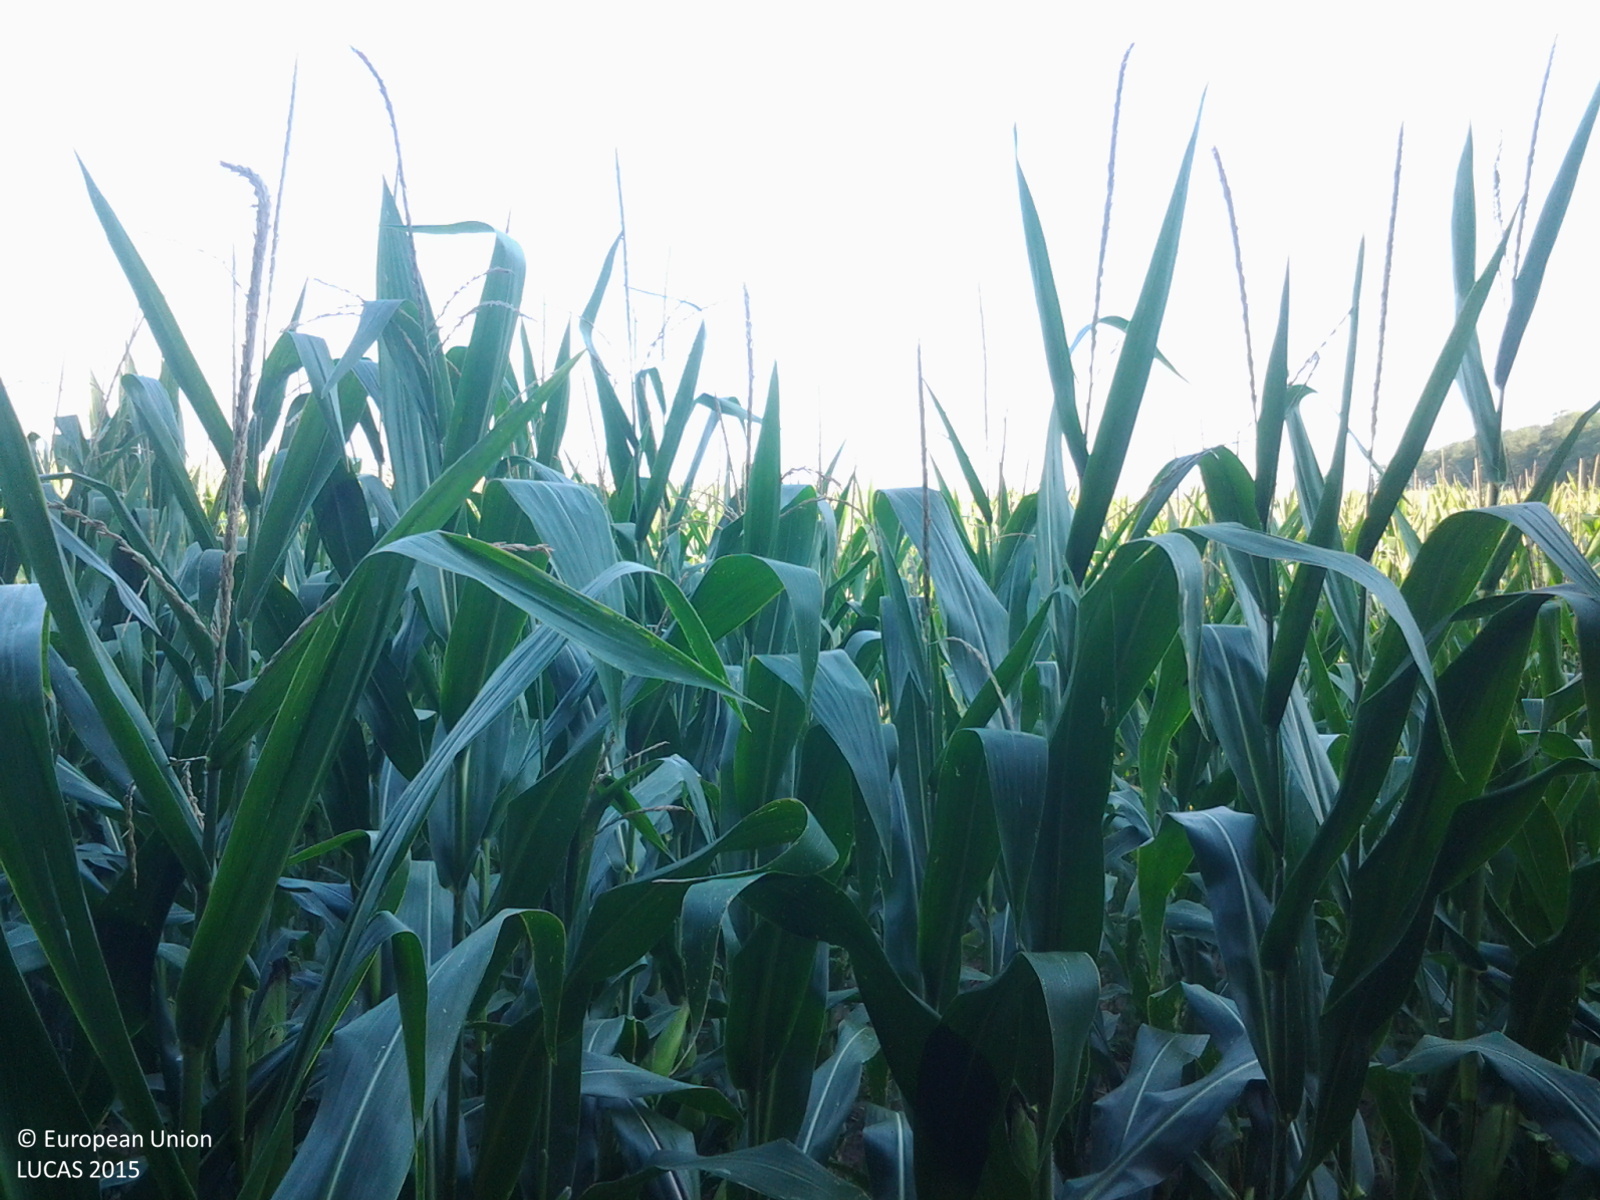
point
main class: Cropland
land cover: Maize
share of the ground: > 75 %
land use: Agriculture (excluding fallow land and kitchen gardens)
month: August
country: HU
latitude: 46.8954
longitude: 21.4719
